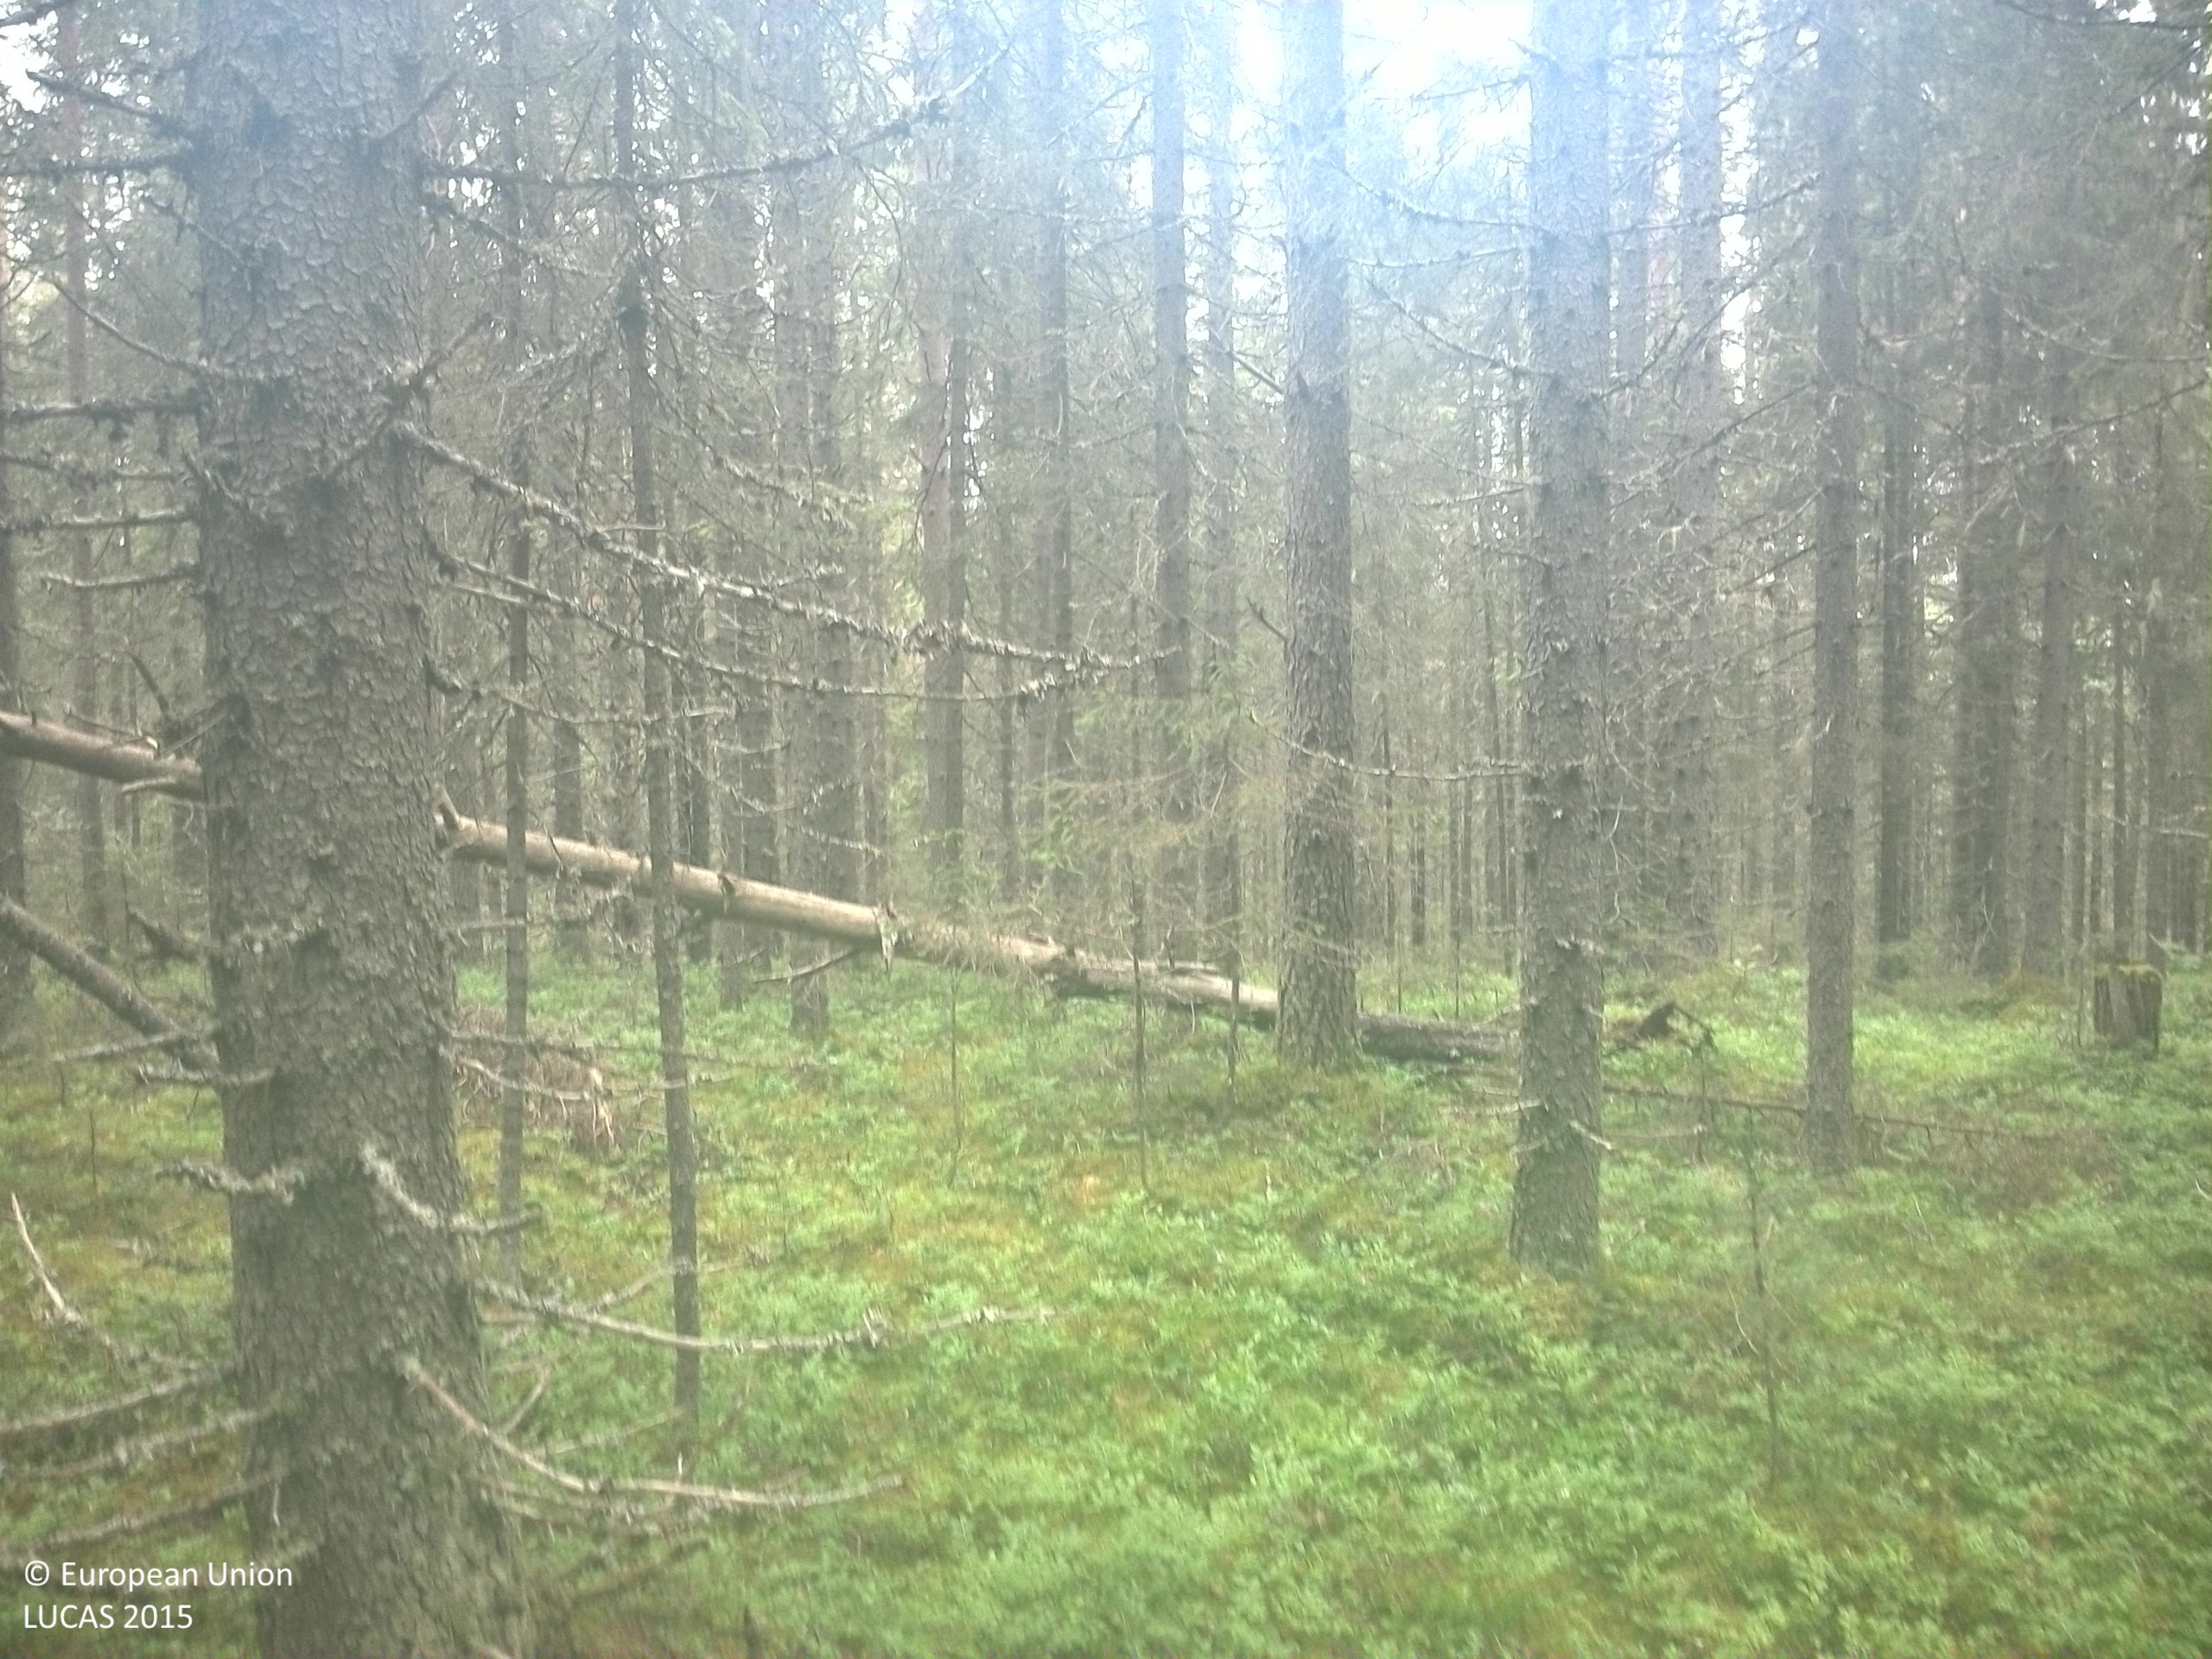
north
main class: Woodland
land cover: Spruce dominated coniferous woodland
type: boreal forest
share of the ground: > 75 %
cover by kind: coniferous forest trees 80 %, shrubs 15 %, broadleaved forest trees 5 %
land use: Forestry
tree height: > 5 m
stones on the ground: < 10 %
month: July
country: SE
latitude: 63.6222
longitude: 18.5492
